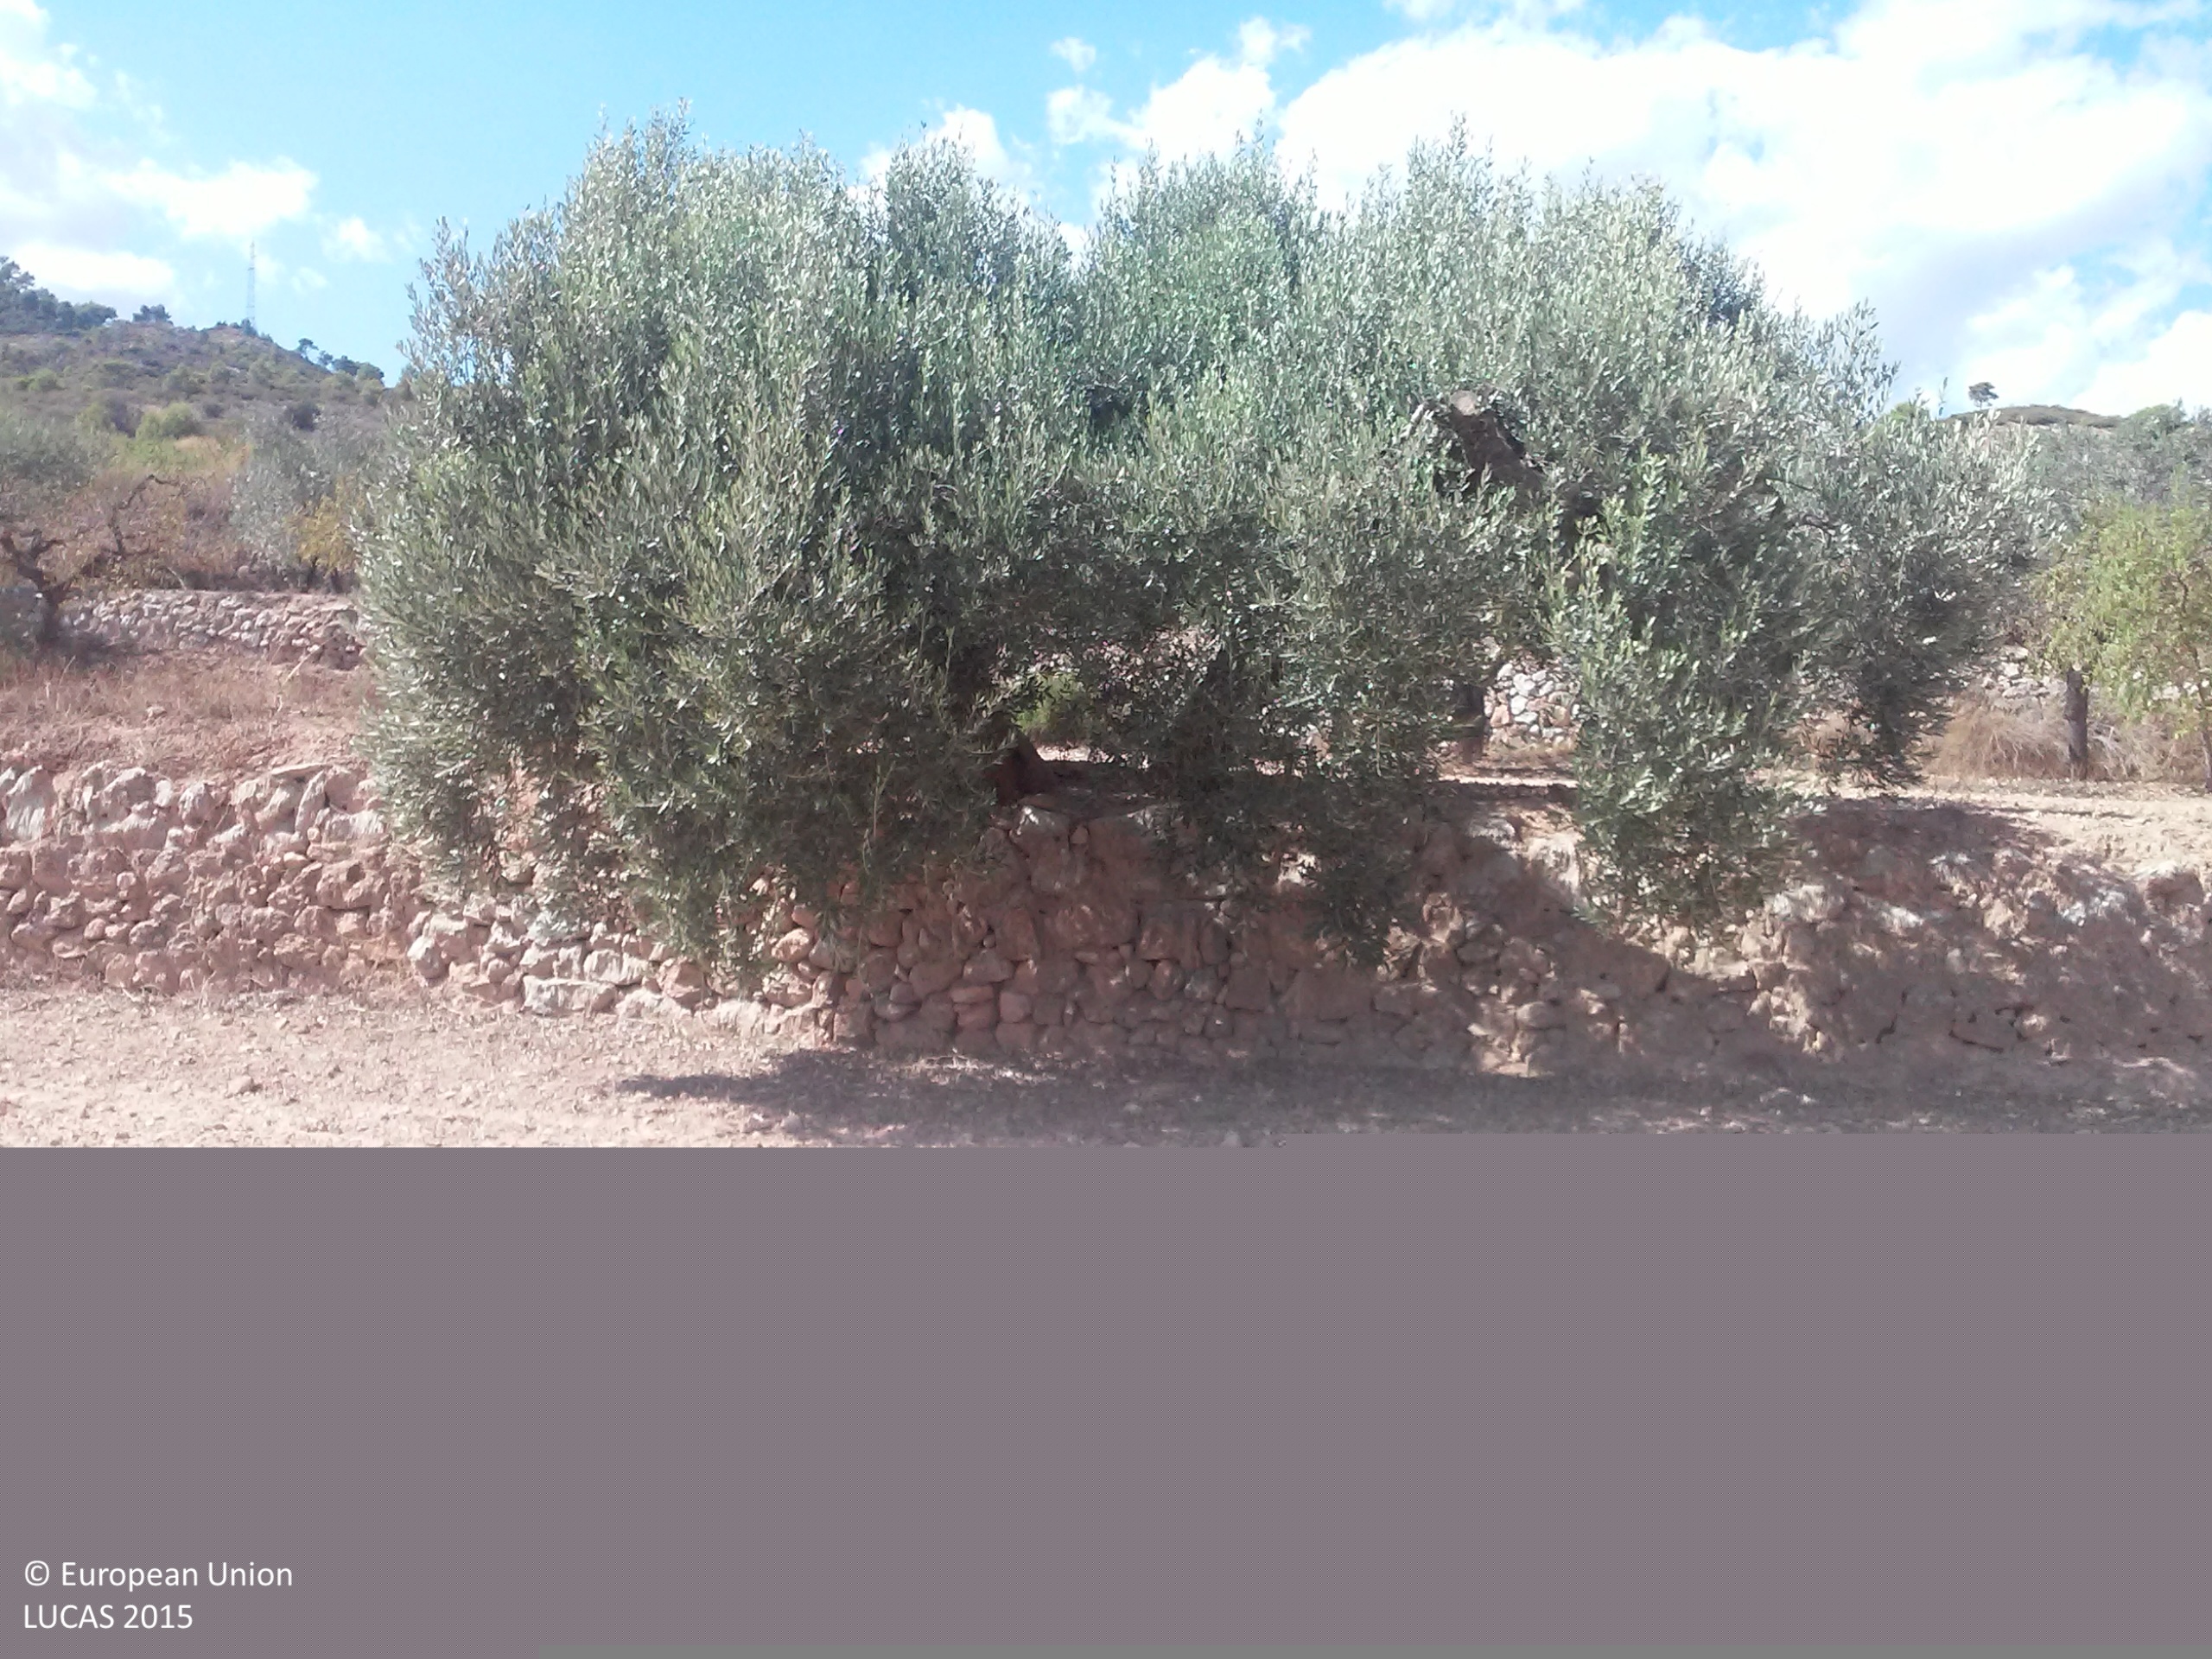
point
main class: Cropland
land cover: Olive groves
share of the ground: < 10 %
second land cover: Other bare soil
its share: > 75 %
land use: Agriculture (excluding fallow land and kitchen gardens)
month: August
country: ES
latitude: 41.0664
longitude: 0.5548
